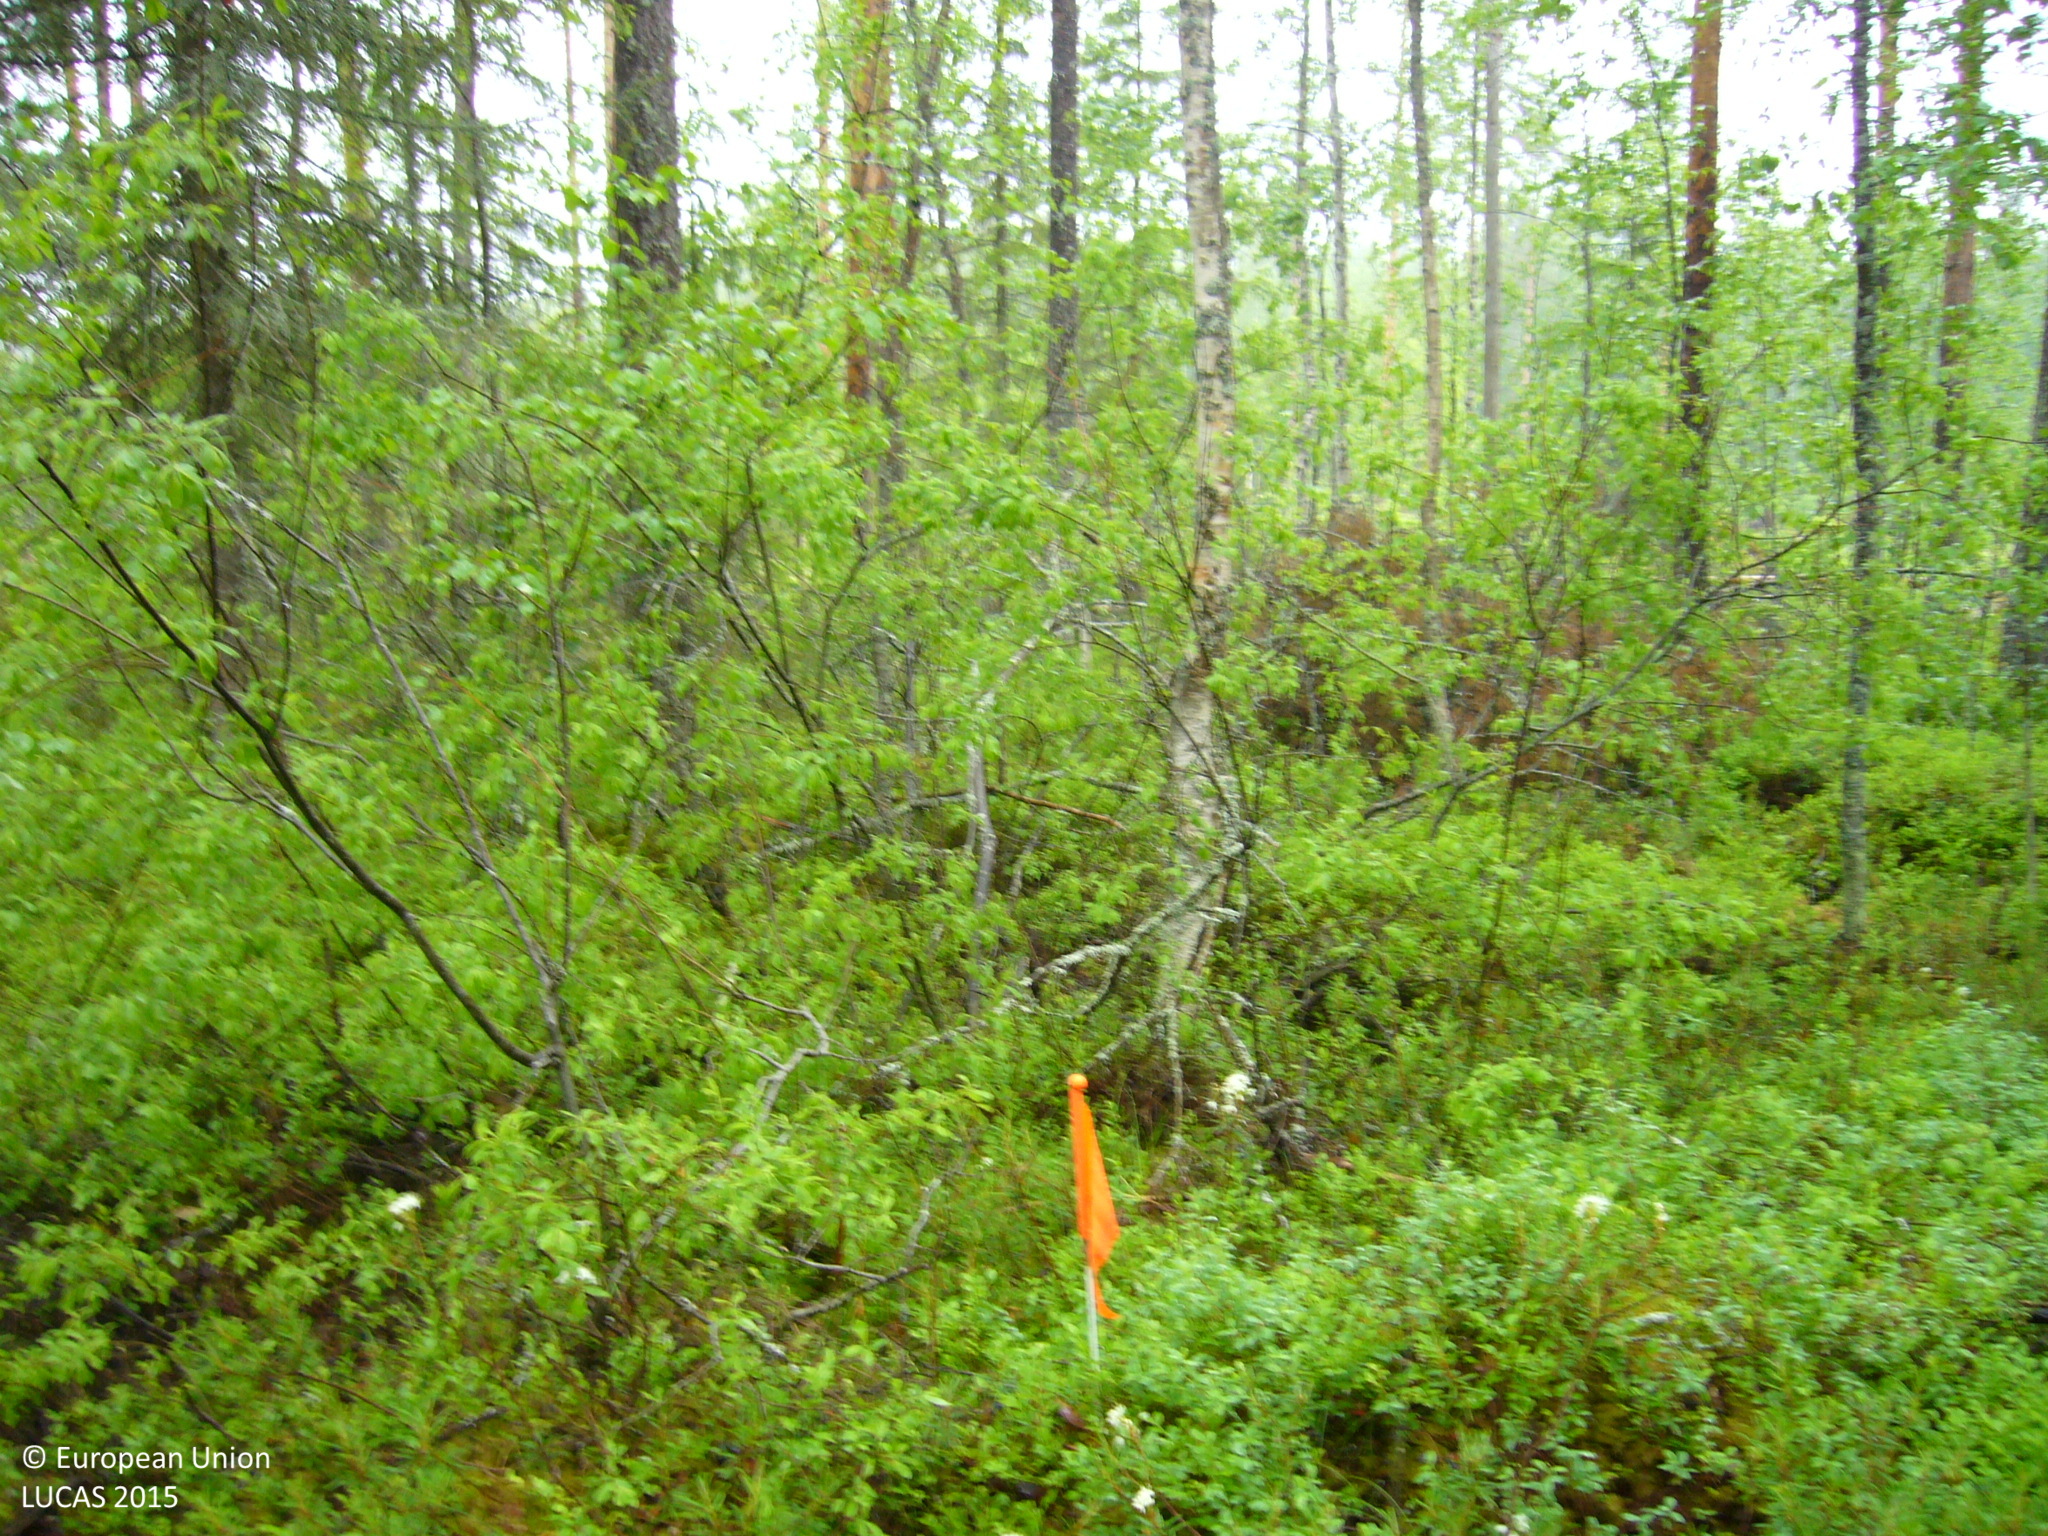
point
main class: Woodland
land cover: Pine dominated mixed woodland
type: boreal forest
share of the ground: 50 - 75 %
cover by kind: coniferous forest trees 40 %, shrubs 35 %, broadleaved forest trees 25 %
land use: Forestry
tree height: > 5 m
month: June
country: FI
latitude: 63.8036
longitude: 25.0517
